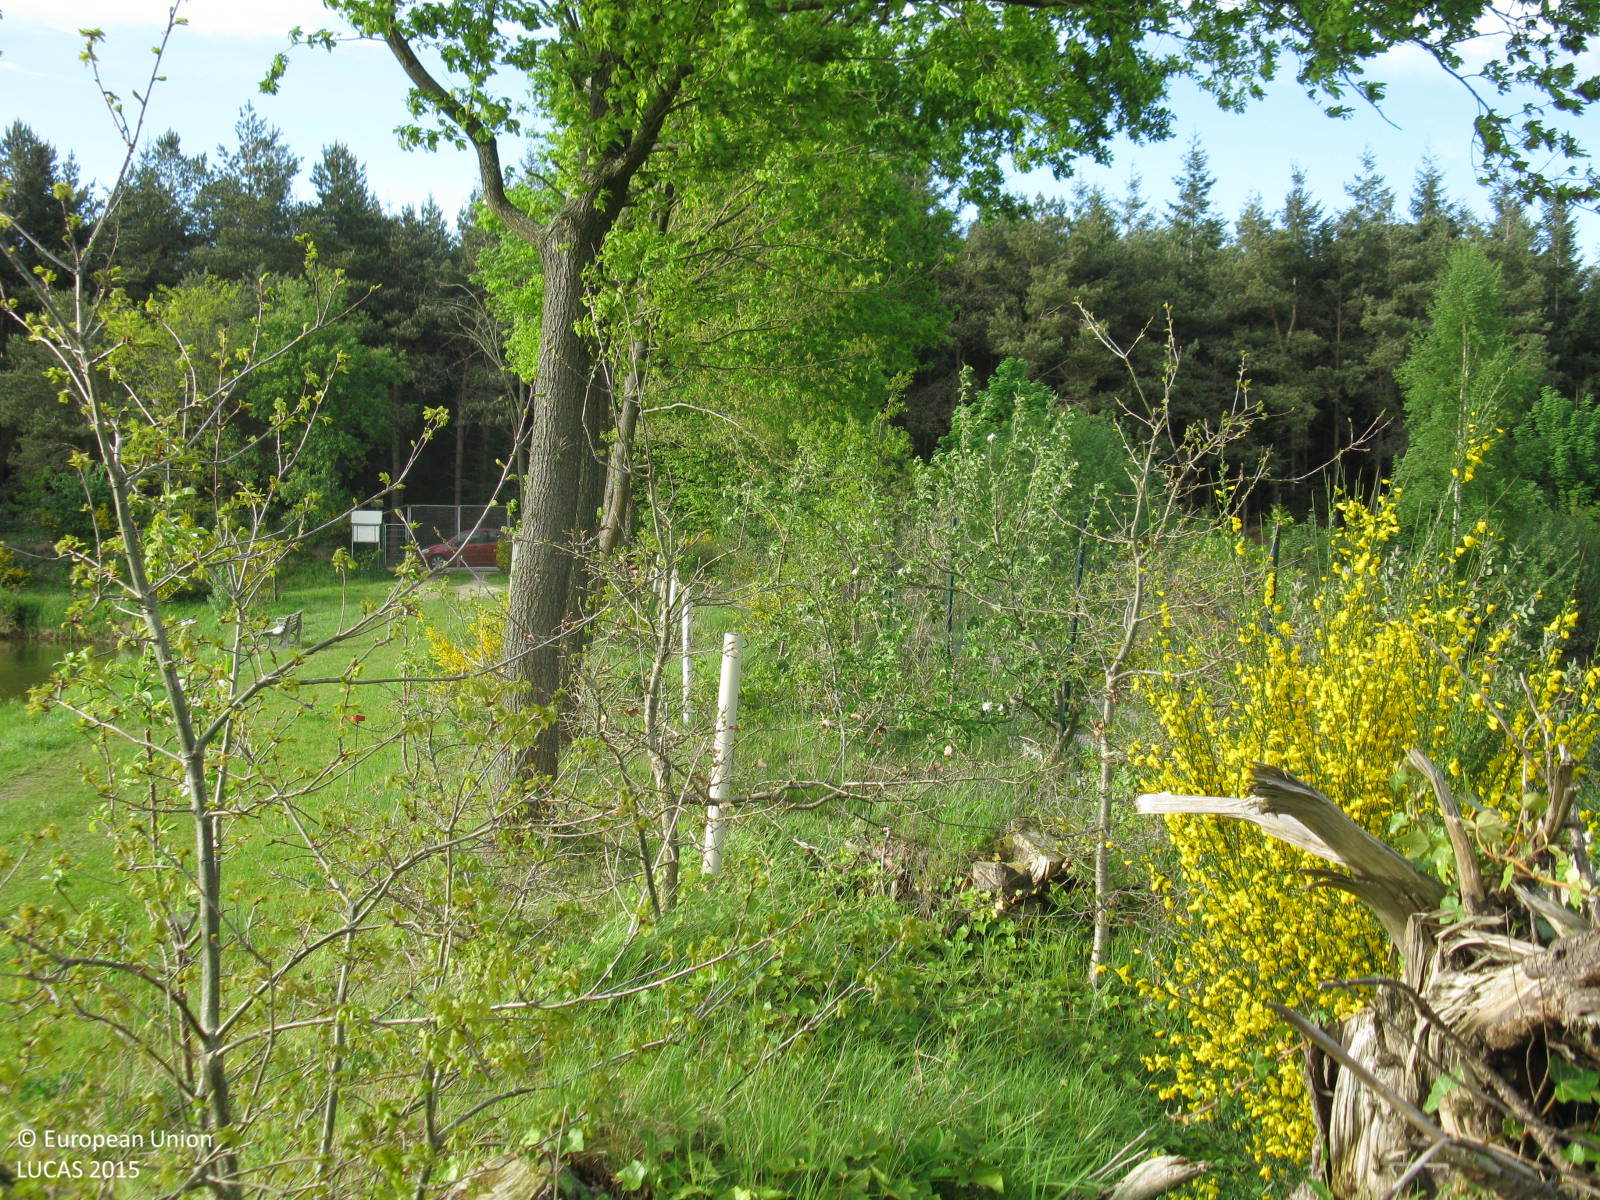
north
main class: Woodland
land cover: Broadleaved woodland
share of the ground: 25 - 50 %
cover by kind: broadleaved forest trees 50 %, herbaceous plants 50 %
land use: Semi-natural and natural areas not in use
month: May
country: DE
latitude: 52.9603
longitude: 7.3953
